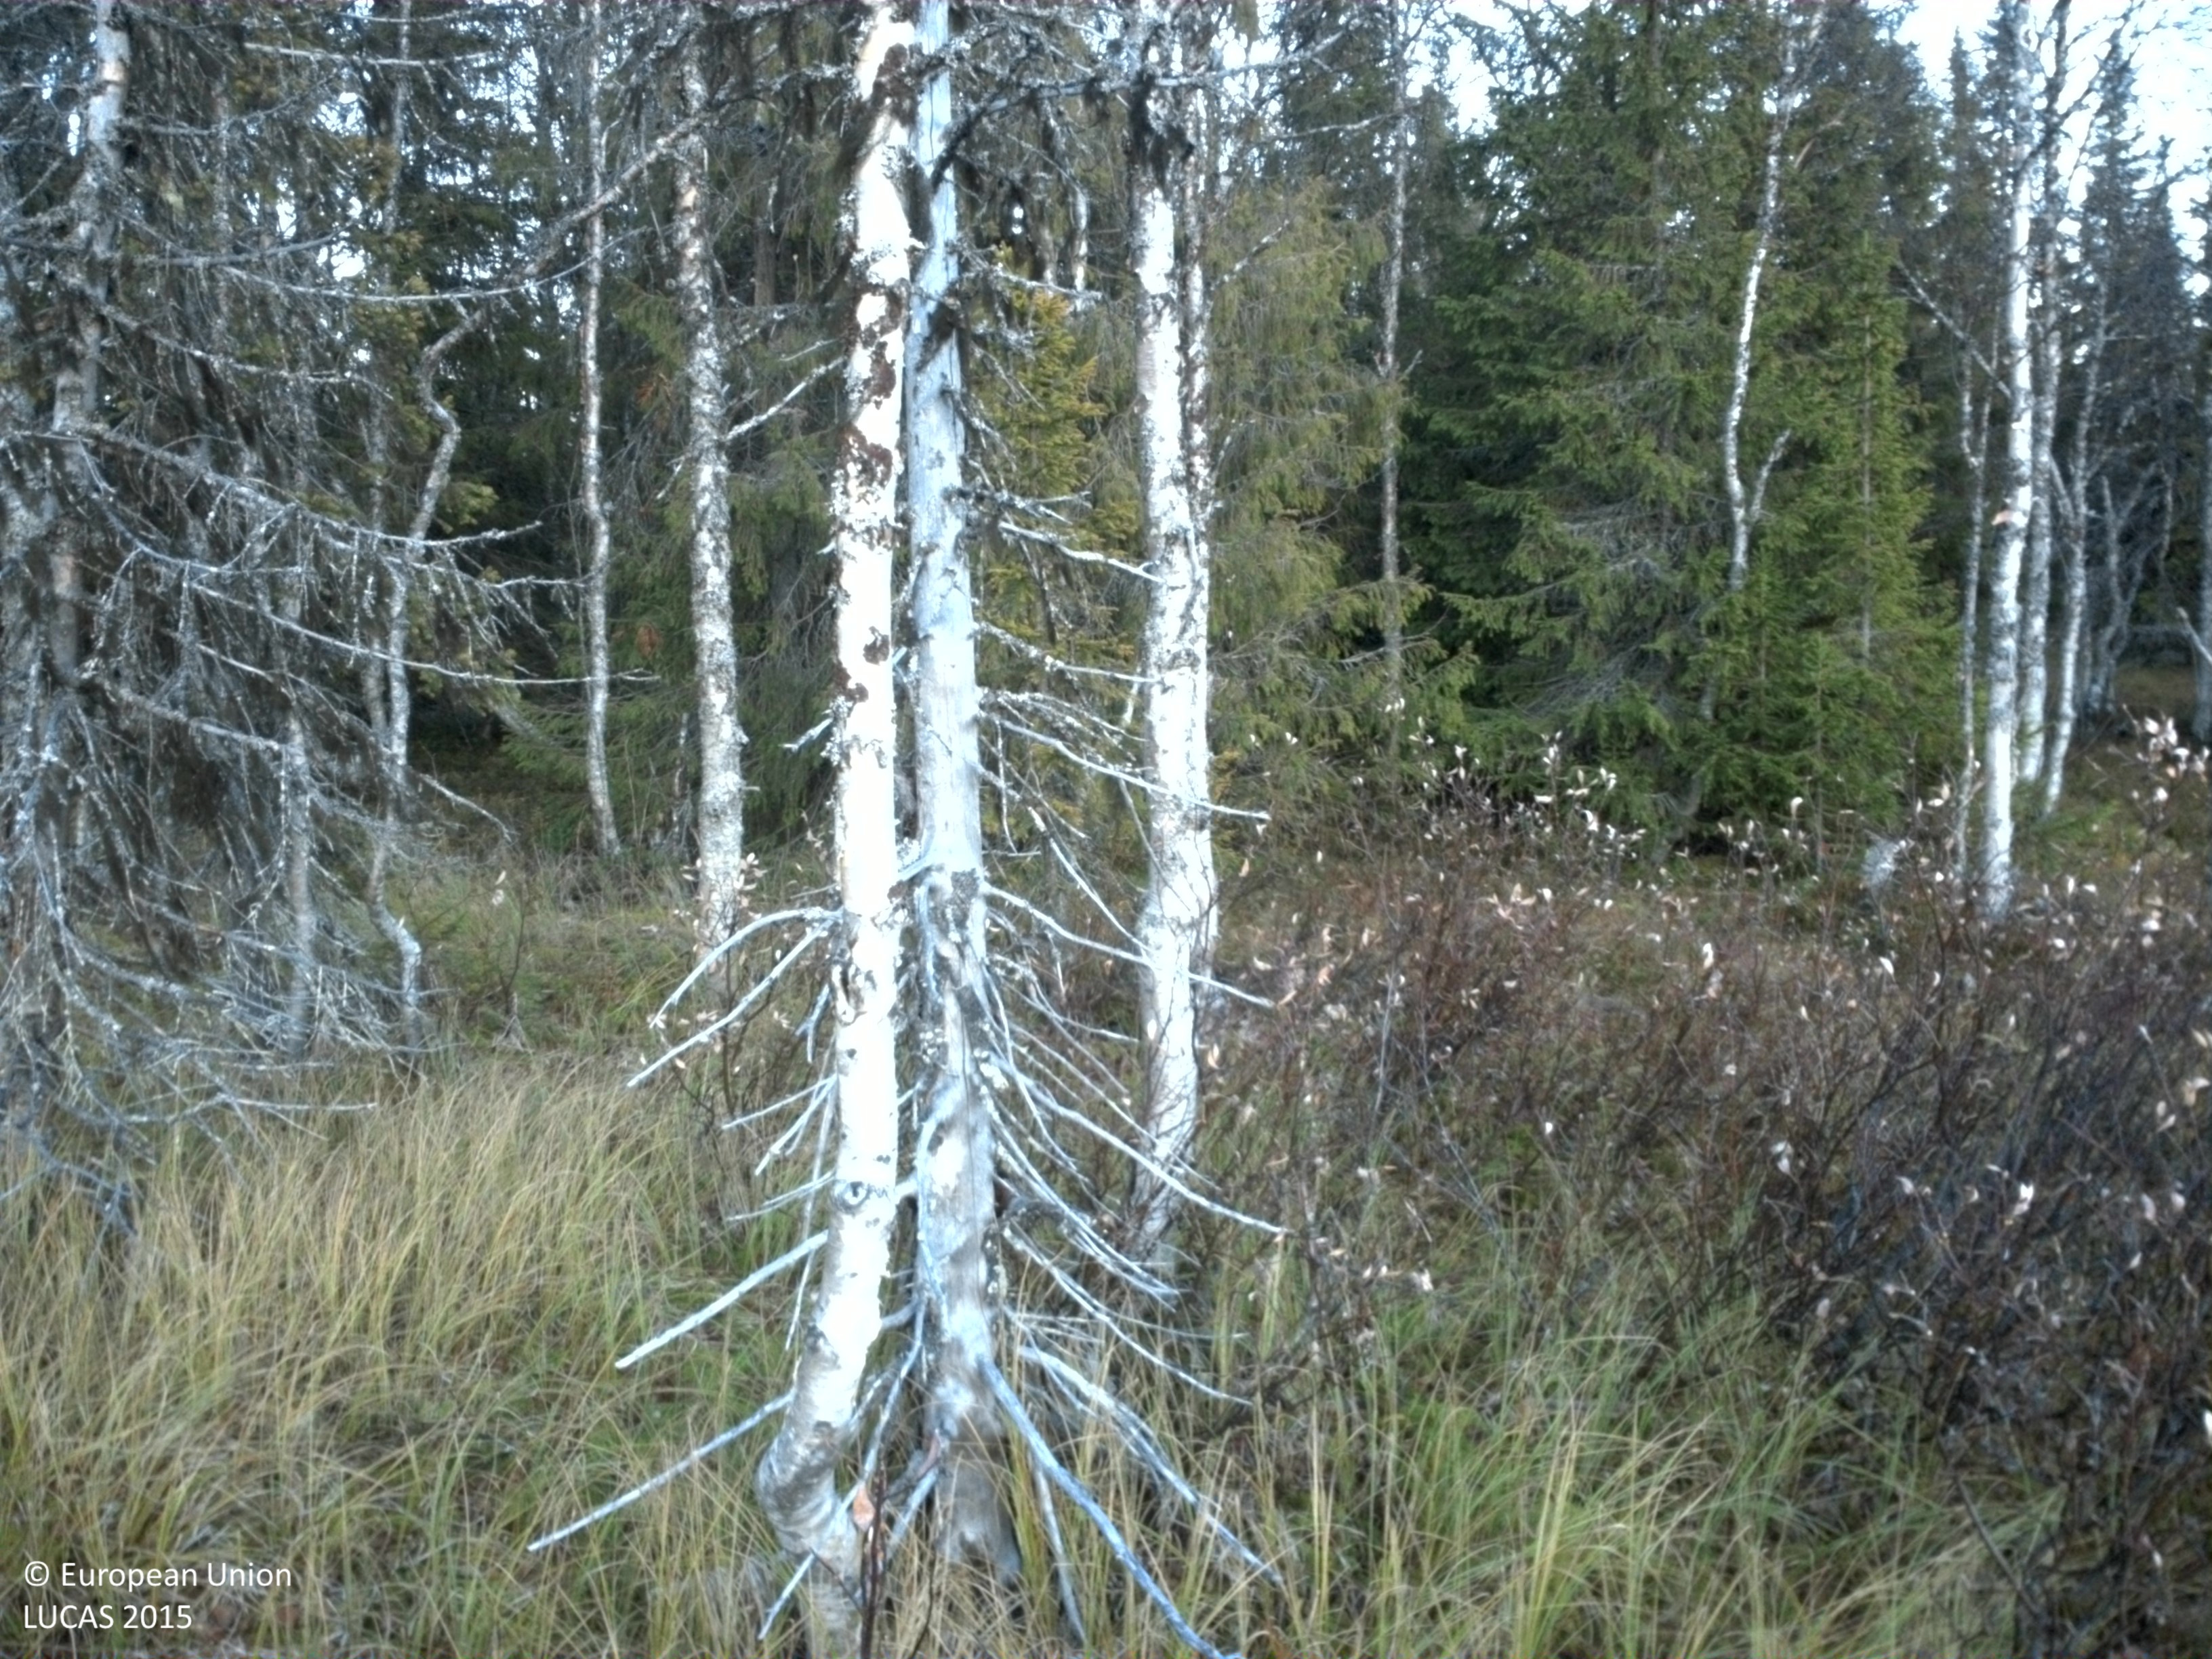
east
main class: Shrubland
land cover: Shrubland without tree cover
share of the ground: 25 - 50 %
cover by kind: herbaceous plants 40 %, shrubs 35 %, lichens and mosses 25 %
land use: Semi-natural and natural areas not in use
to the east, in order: Shrubland without tree cover; Spruce dominated mixed woodland; Spruce dominated coniferous woodland; Grassland without tree/shrub cover; Other structural elements; Paved roads, cycling and walking lanes; Other bare soil; Ditches and canals; Grassland with sparse tree/shrub cover; Broadleaved woodland
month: October
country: SE
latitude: 64.7309
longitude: 17.4610
